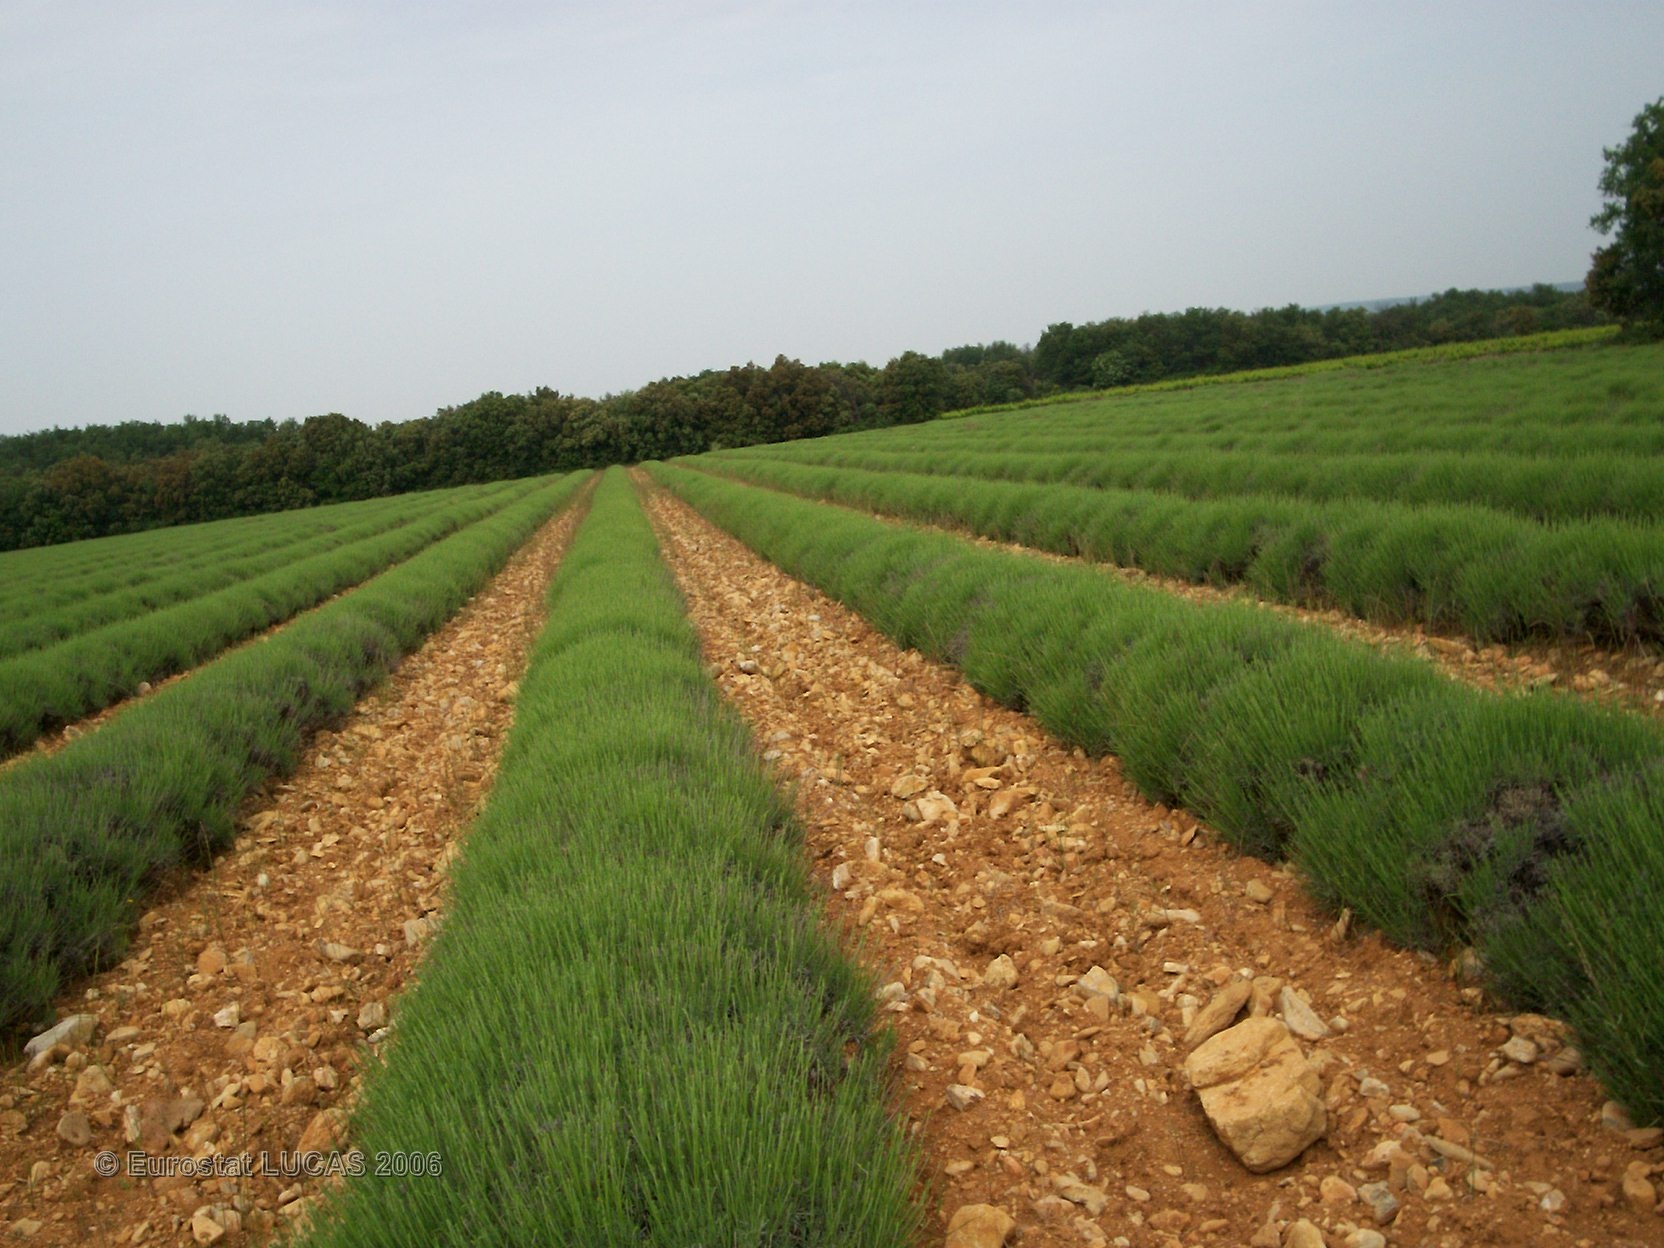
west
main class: Cropland
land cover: Permanent industrial crops
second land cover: Bare land
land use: Agriculture (excluding fallow land and kitchen gardens)
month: May
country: FR
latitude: 44.3709
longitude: 4.9248
